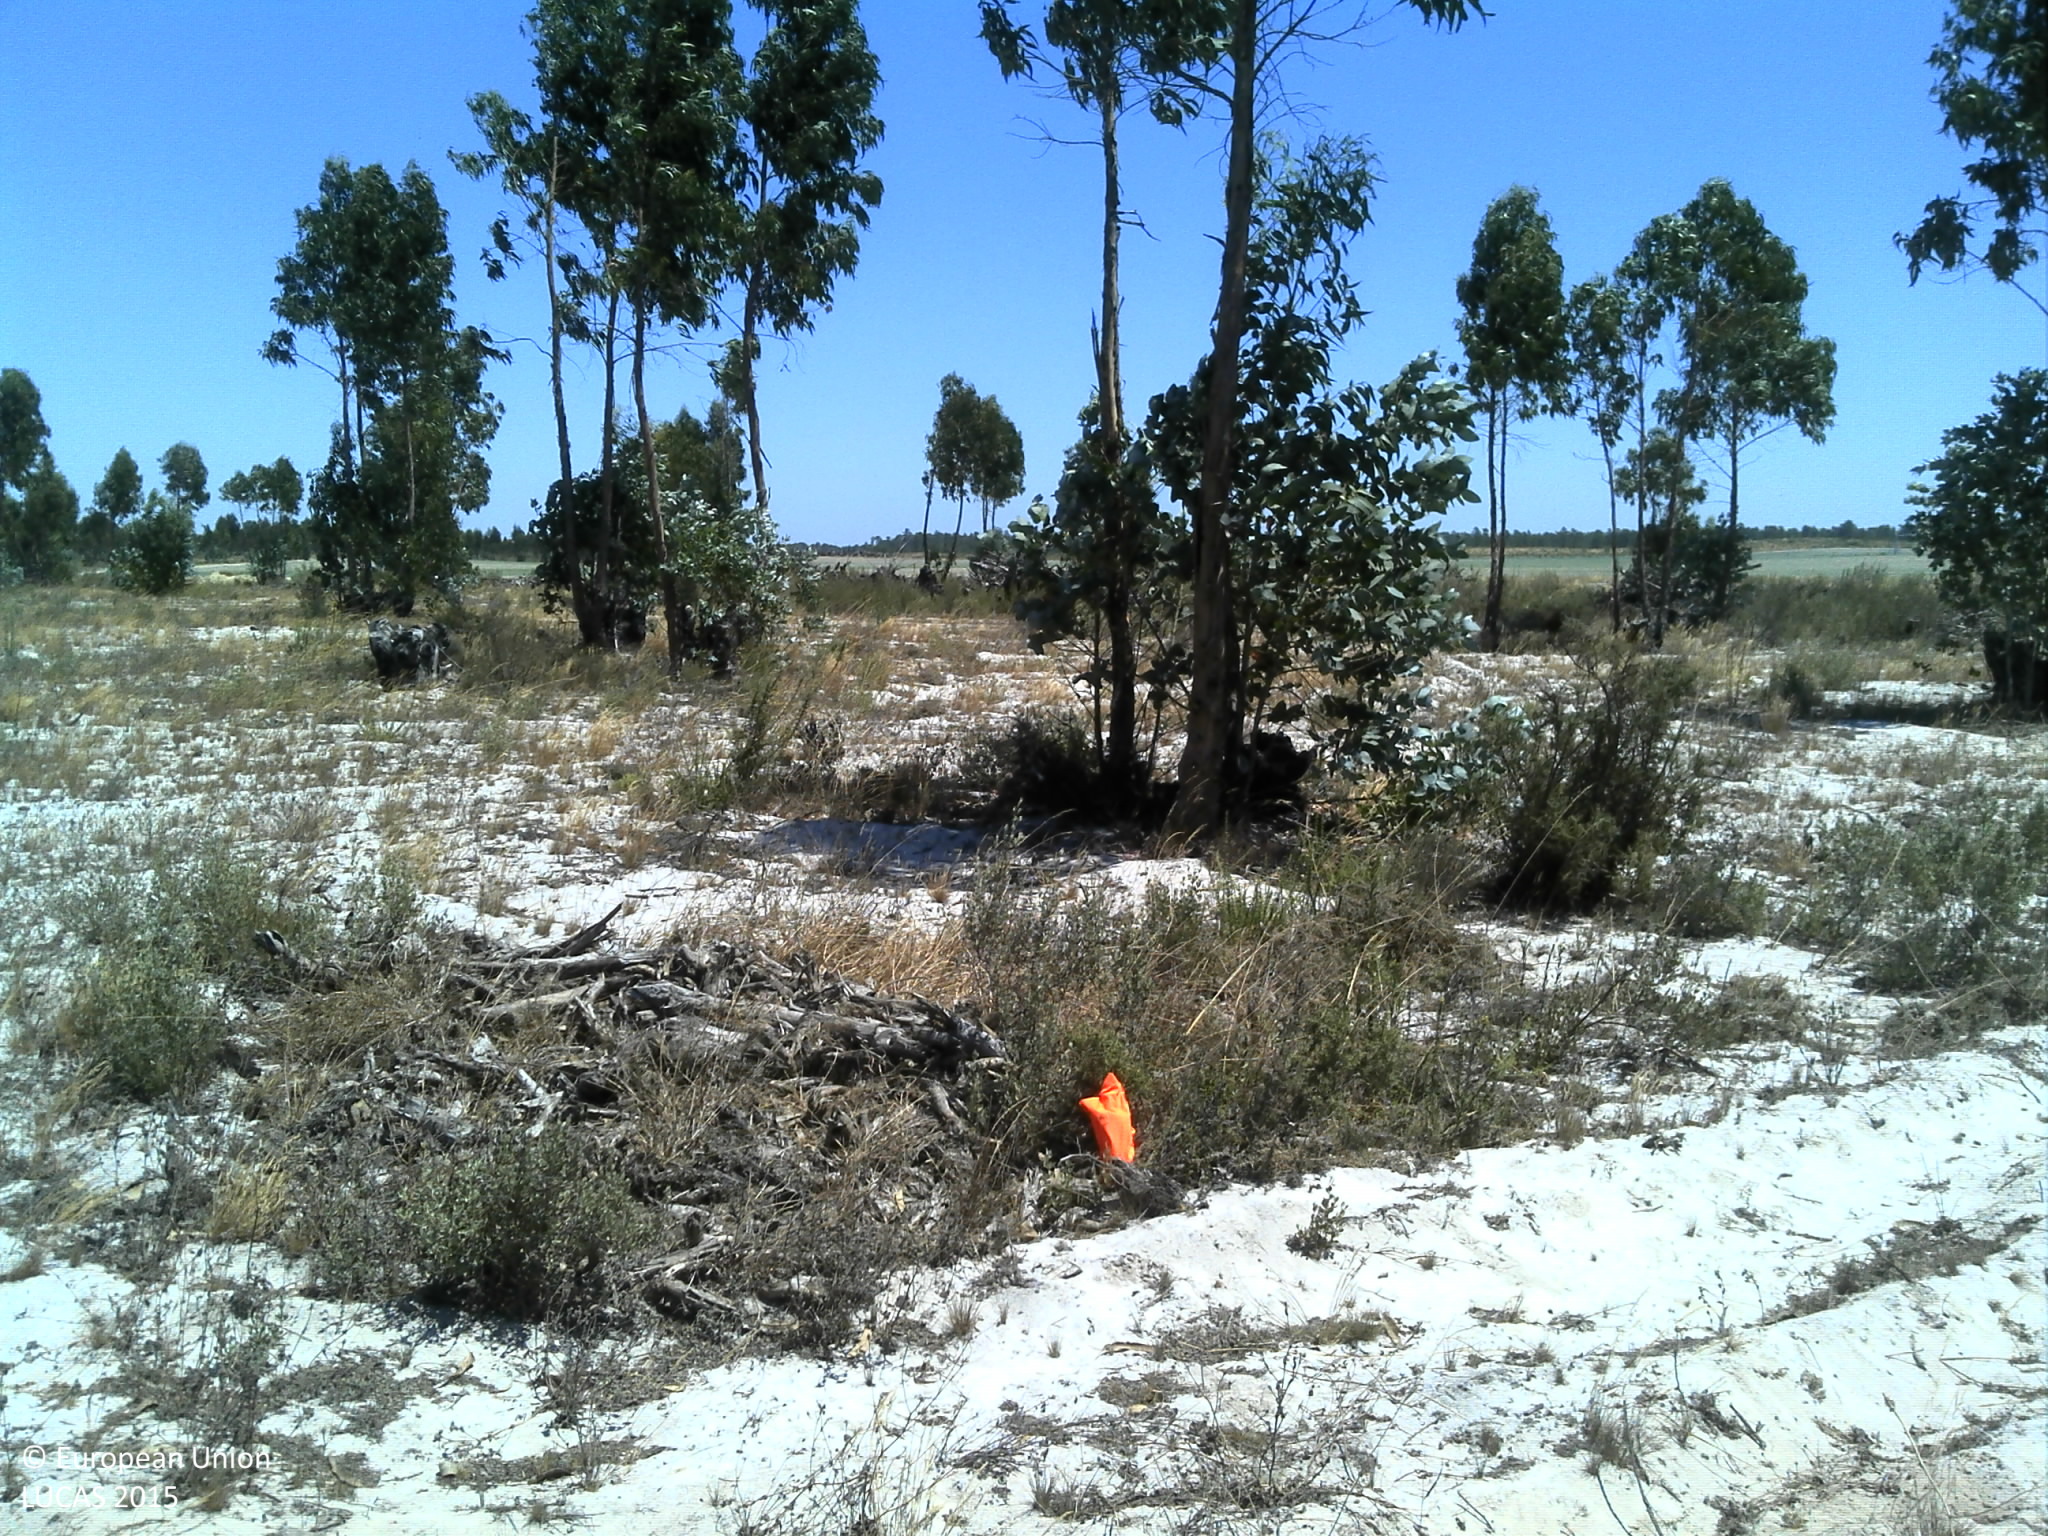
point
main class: Woodland
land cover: Broadleaved woodland
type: exotic forest
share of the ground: 10 - 25 %
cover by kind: unconsolidated bare surface 55 %, shrubs 25 %, broadleaved forest trees 15 %, herbaceous plants 5 %
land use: Forestry
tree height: > 5 m
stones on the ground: < 10 %
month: July
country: PT
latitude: 38.3370
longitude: -8.7151
